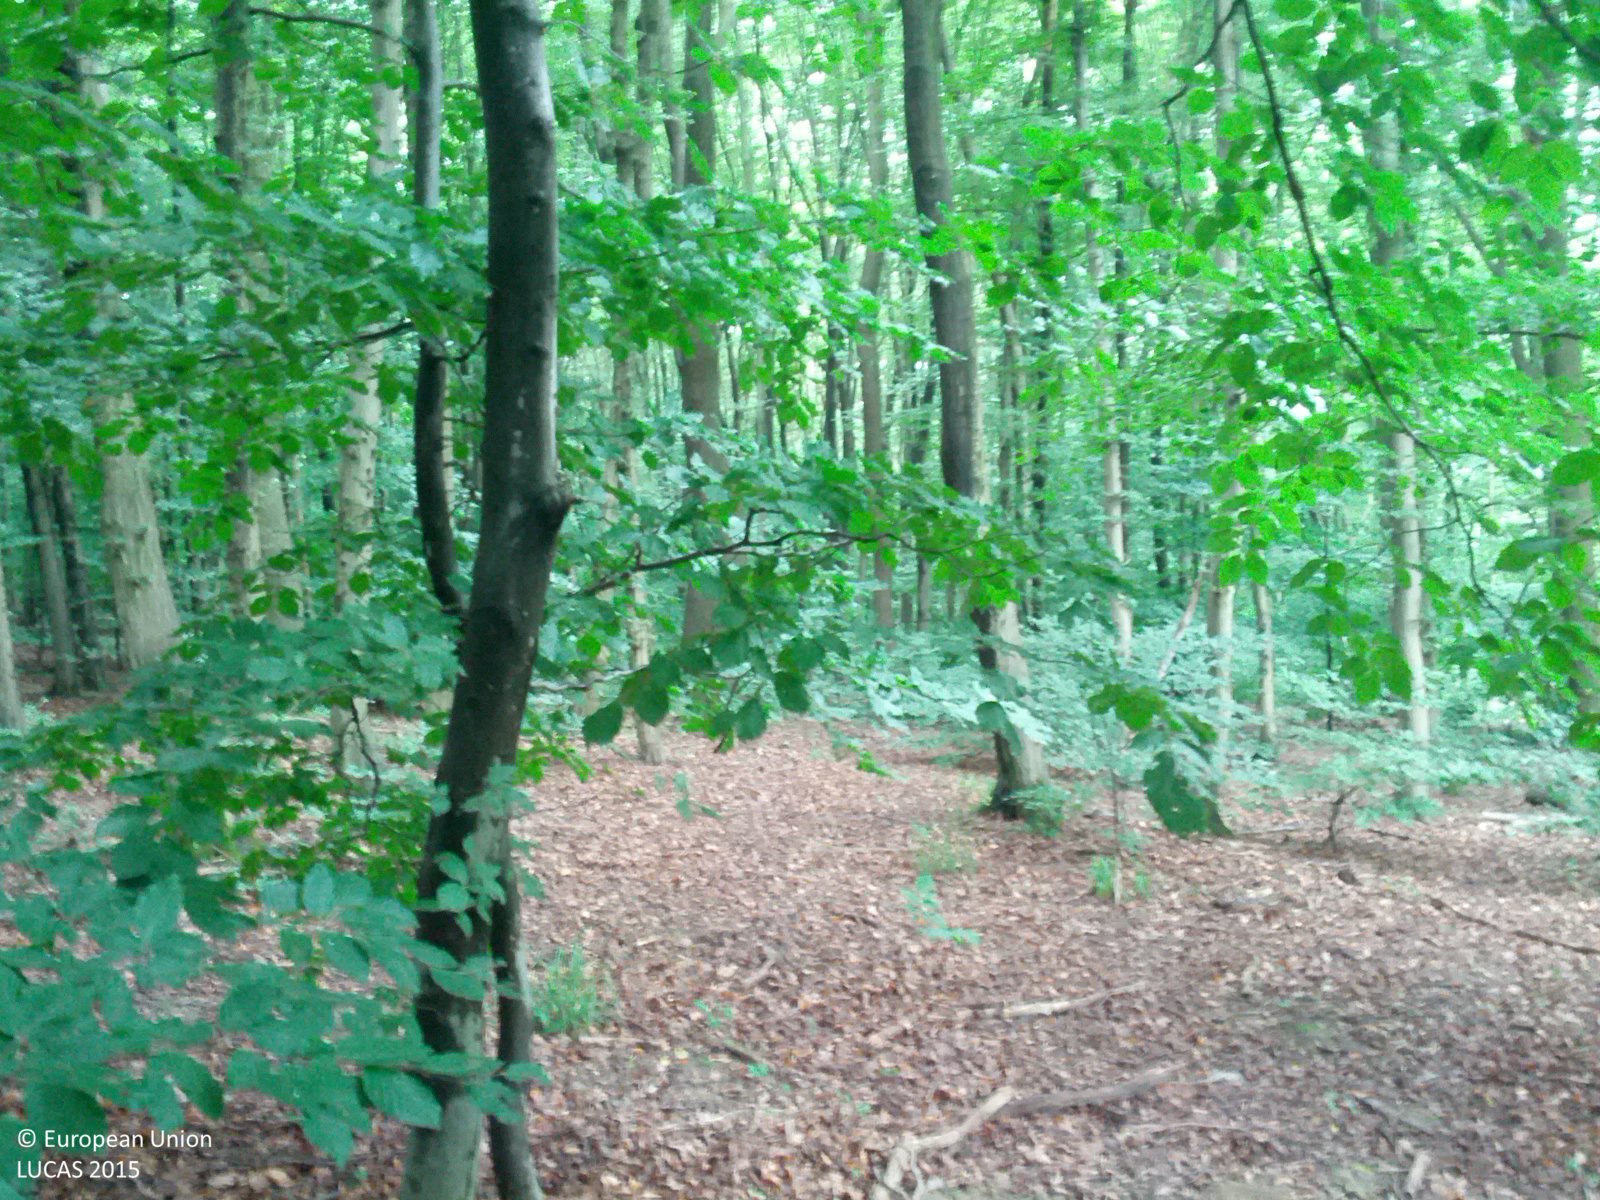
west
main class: Woodland
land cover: Broadleaved woodland
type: beech forest
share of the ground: > 75 %
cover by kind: broadleaved forest trees 90 %, herbaceous plants 10 %
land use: Forestry
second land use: Amenities, museums, leisure
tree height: > 5 m
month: June
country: AT
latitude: 48.2423
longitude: 16.2932
